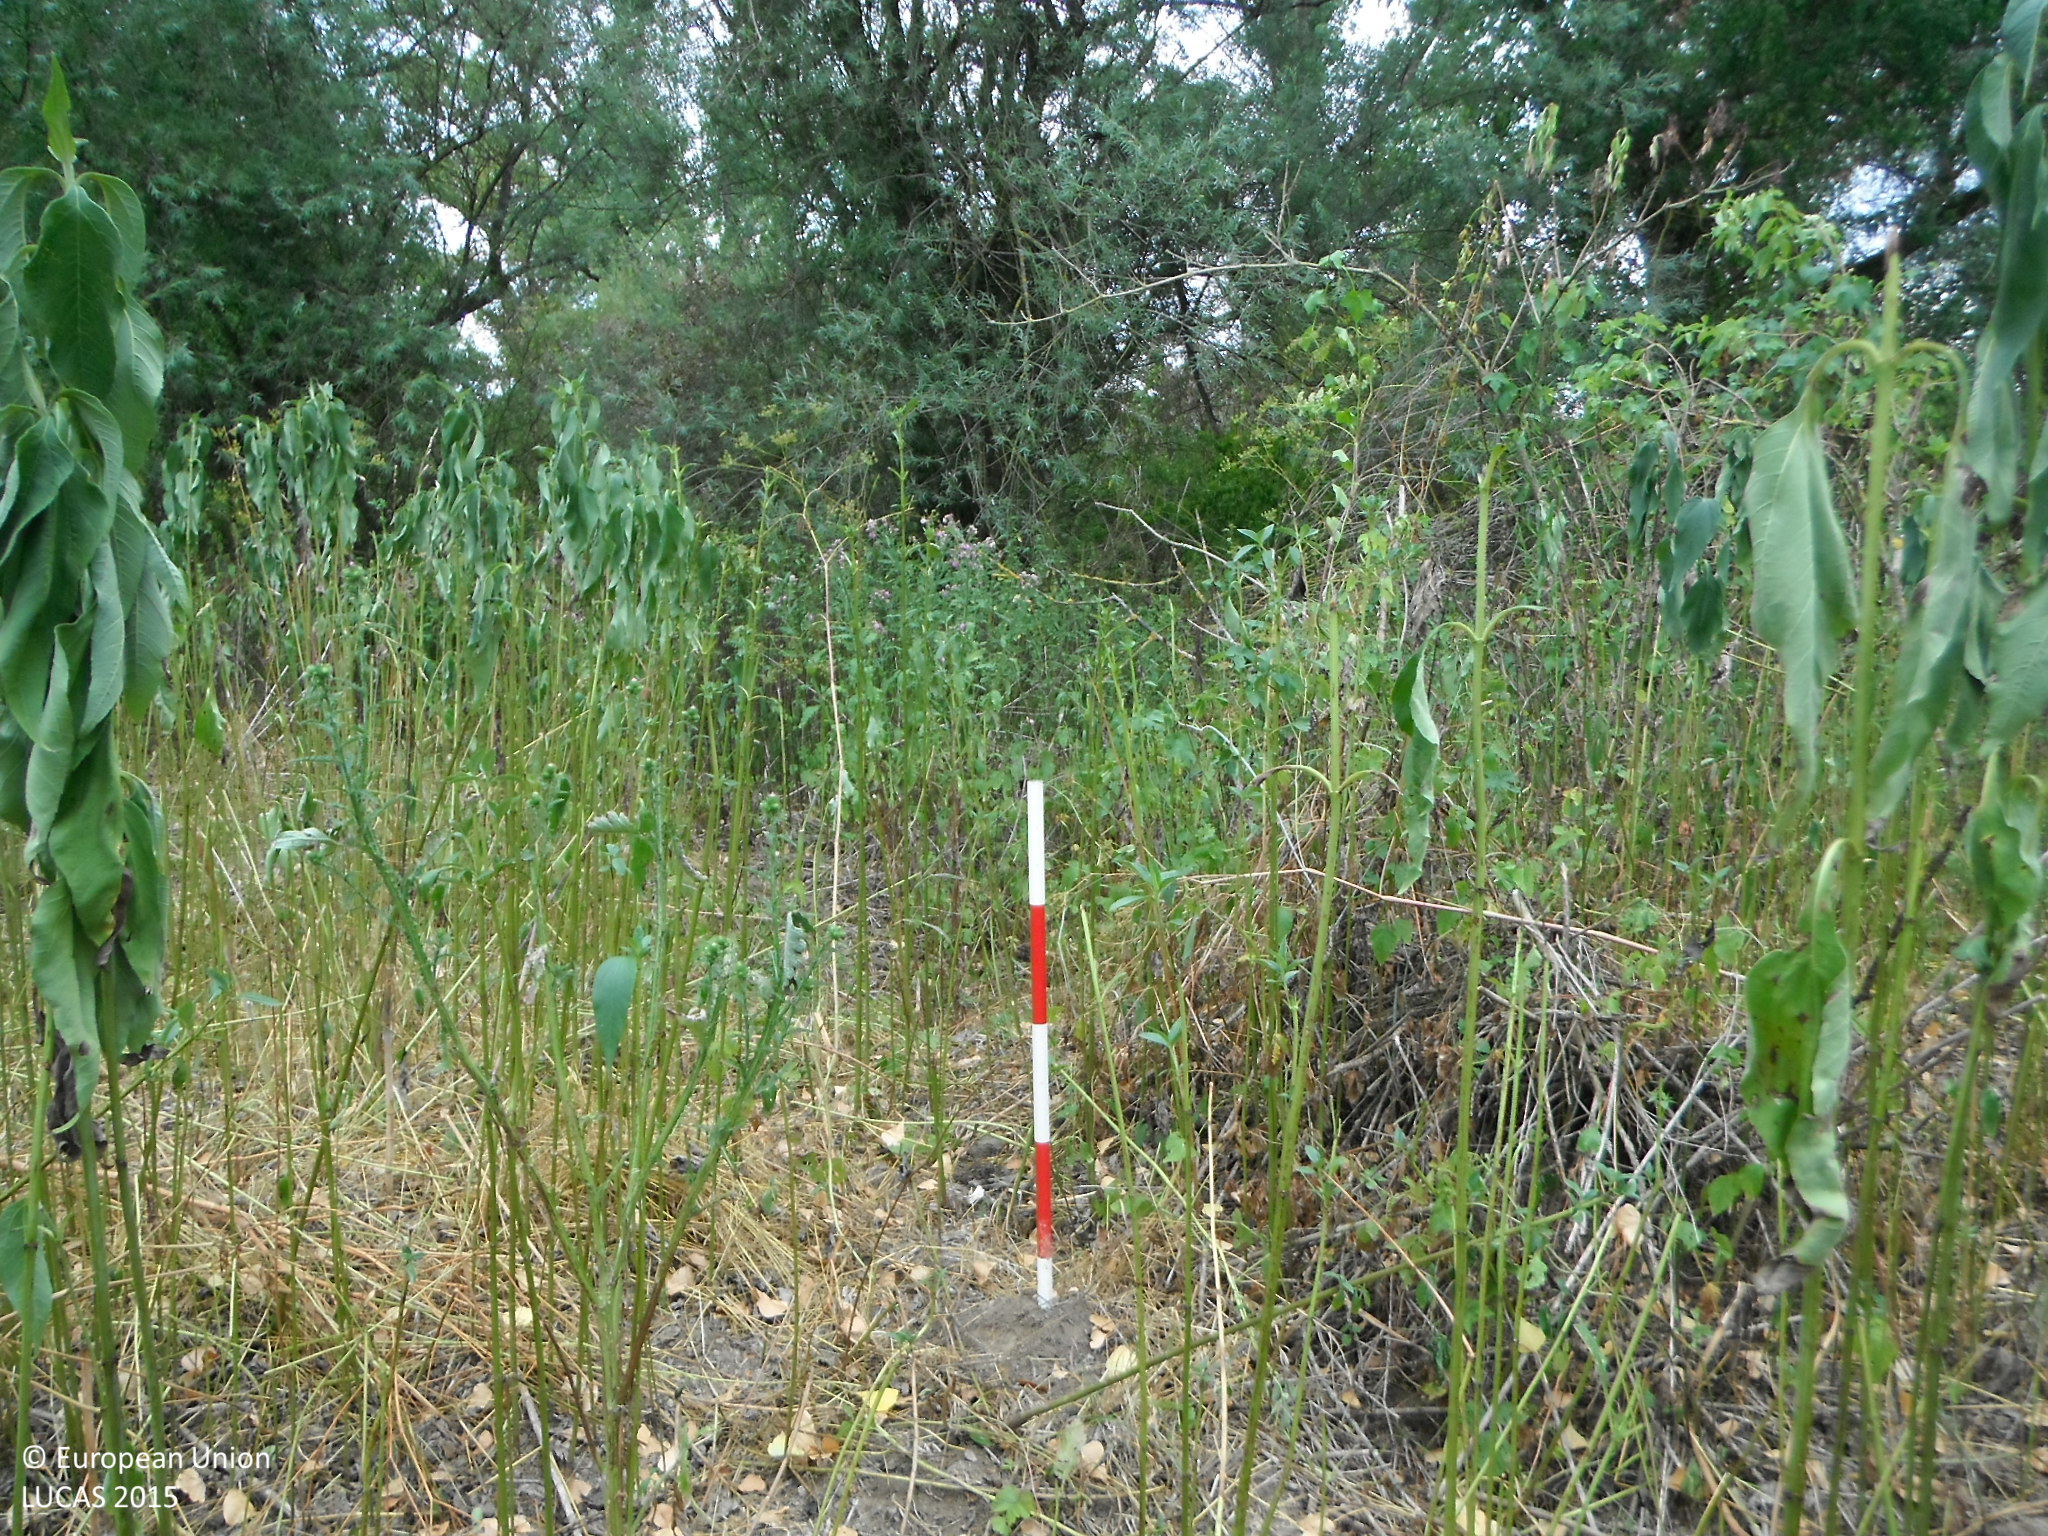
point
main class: Shrubland
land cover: Shrubland with sparse tree cover
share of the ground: > 75 %
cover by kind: shrubs 90 %, broadleaved forest trees 5 %, herbaceous plants 5 %
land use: Semi-natural and natural areas not in use
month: July
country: SK
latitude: 48.8236
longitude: 17.9273
